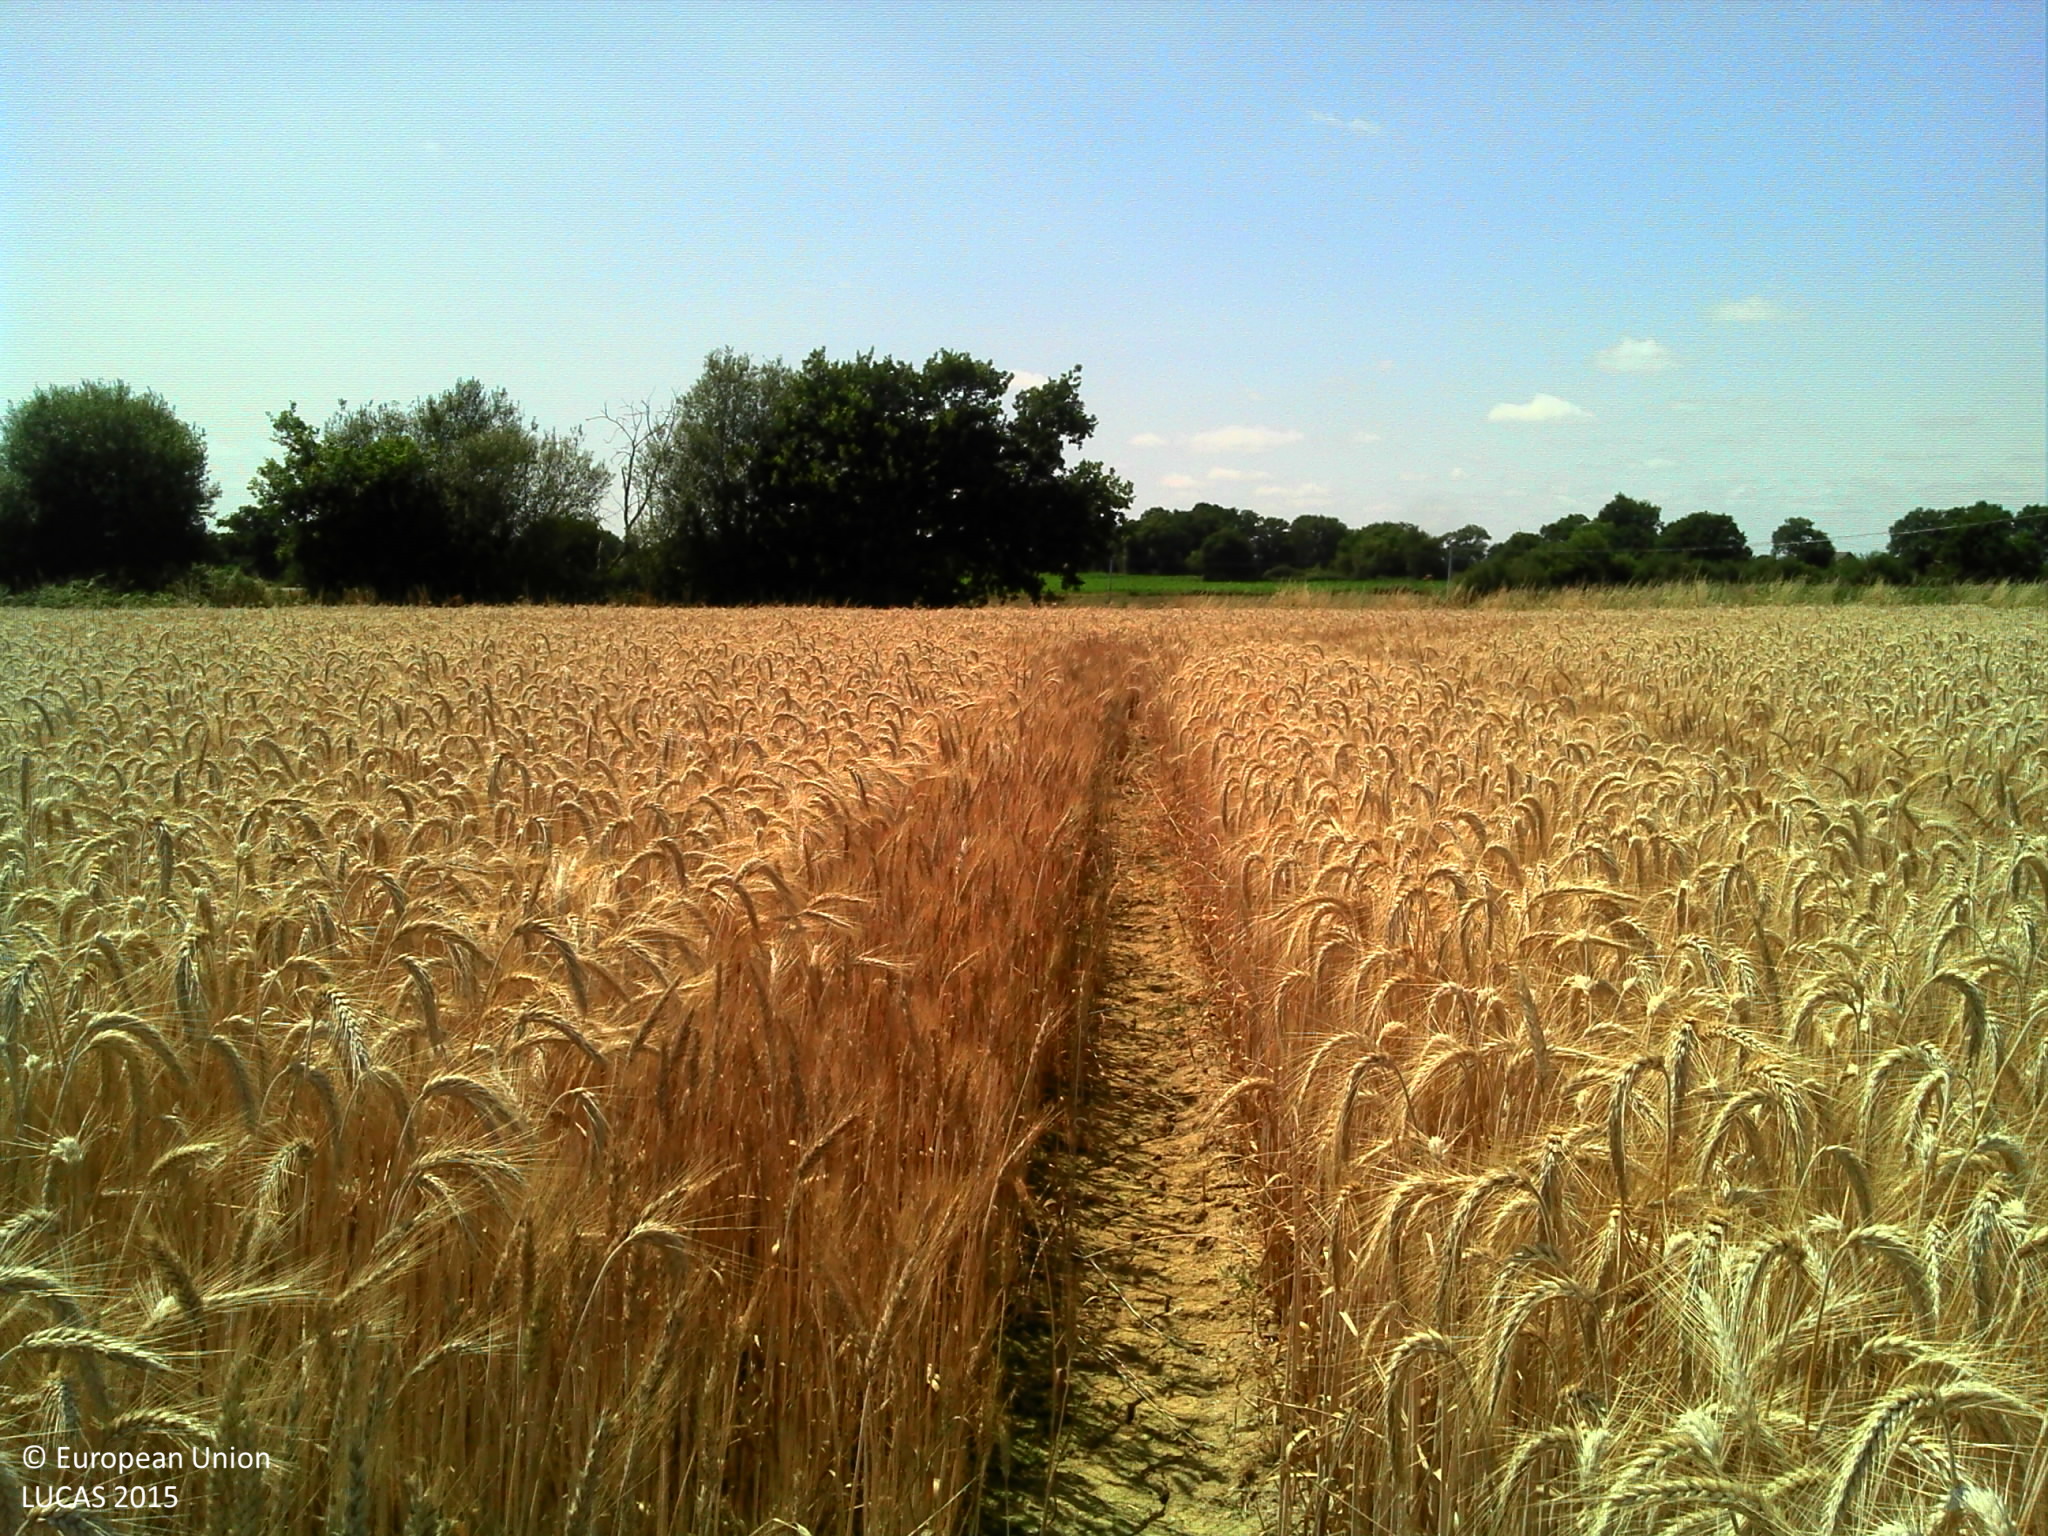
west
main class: Cropland
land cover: Barley
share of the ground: > 75 %
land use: Agriculture (excluding fallow land and kitchen gardens)
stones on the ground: < 10 %
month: July
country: FR
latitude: 47.8670
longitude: -1.3929
